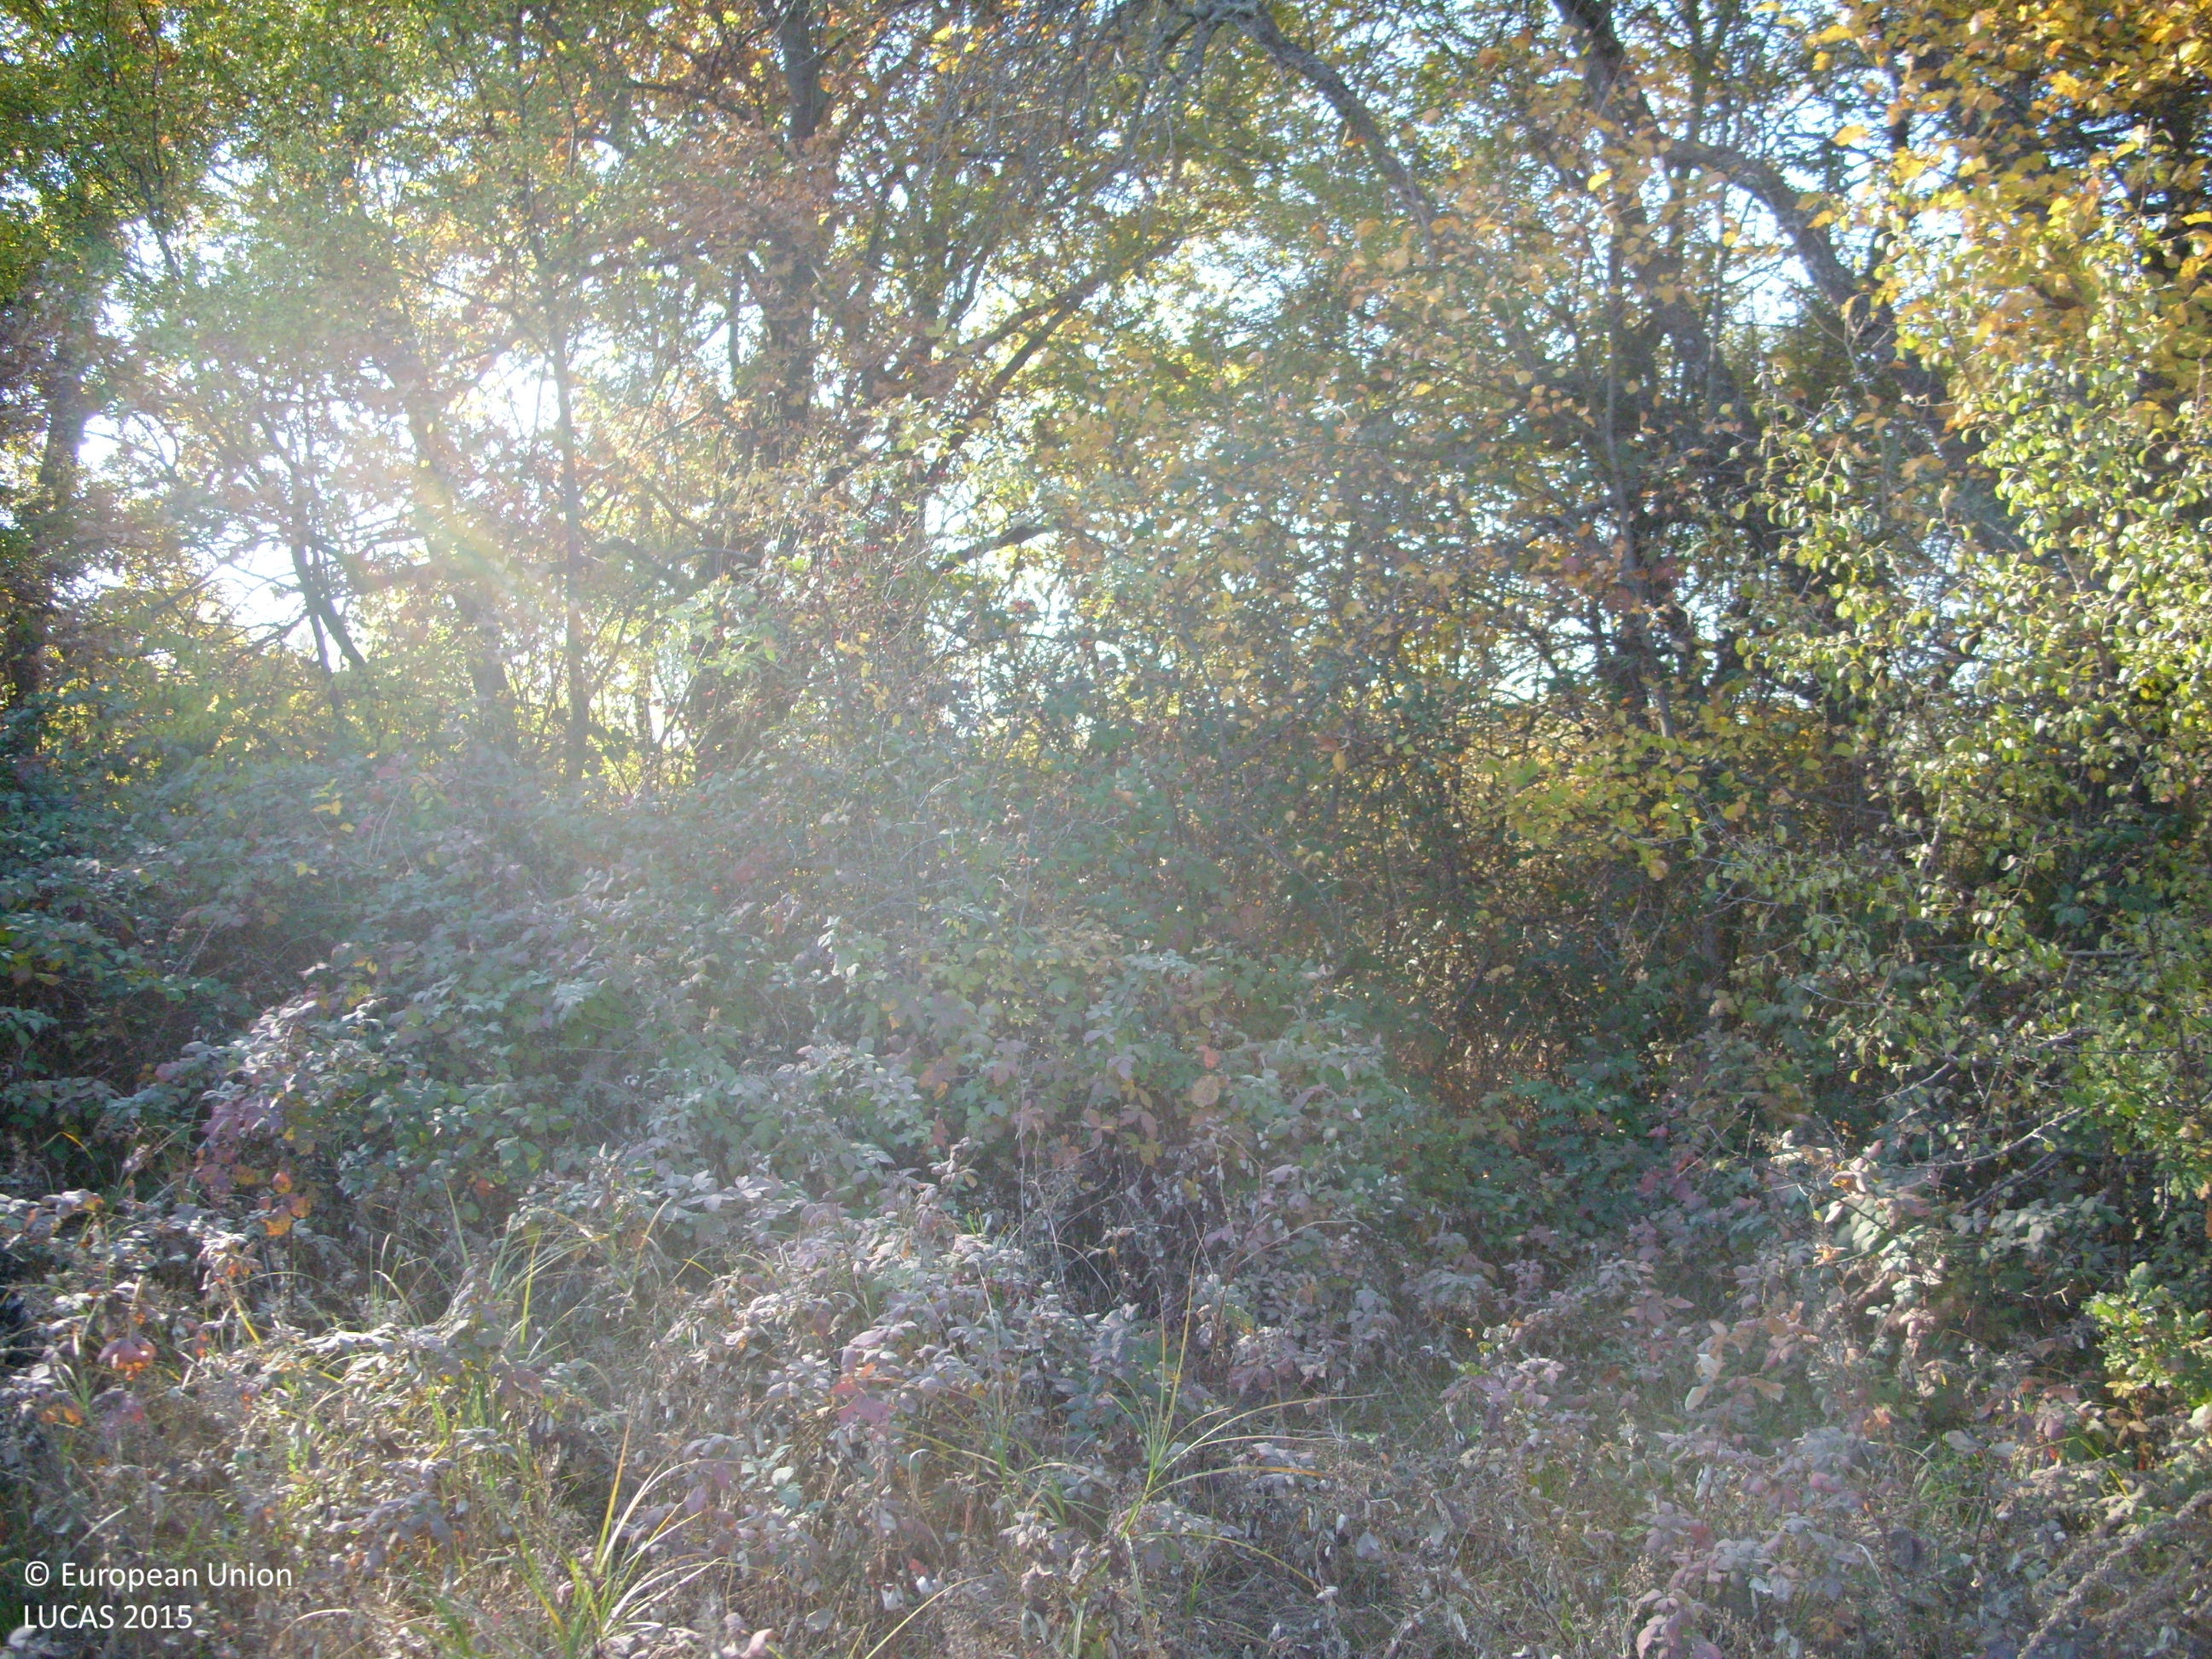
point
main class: Woodland
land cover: Broadleaved woodland
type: mesophytic deciduous forest
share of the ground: > 75 %
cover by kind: broadleaved forest trees 90 %, shrubs 10 %
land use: Semi-natural and natural areas not in use
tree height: > 5 m
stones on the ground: < 10 %
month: November
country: BG
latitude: 42.4464
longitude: 24.8781
